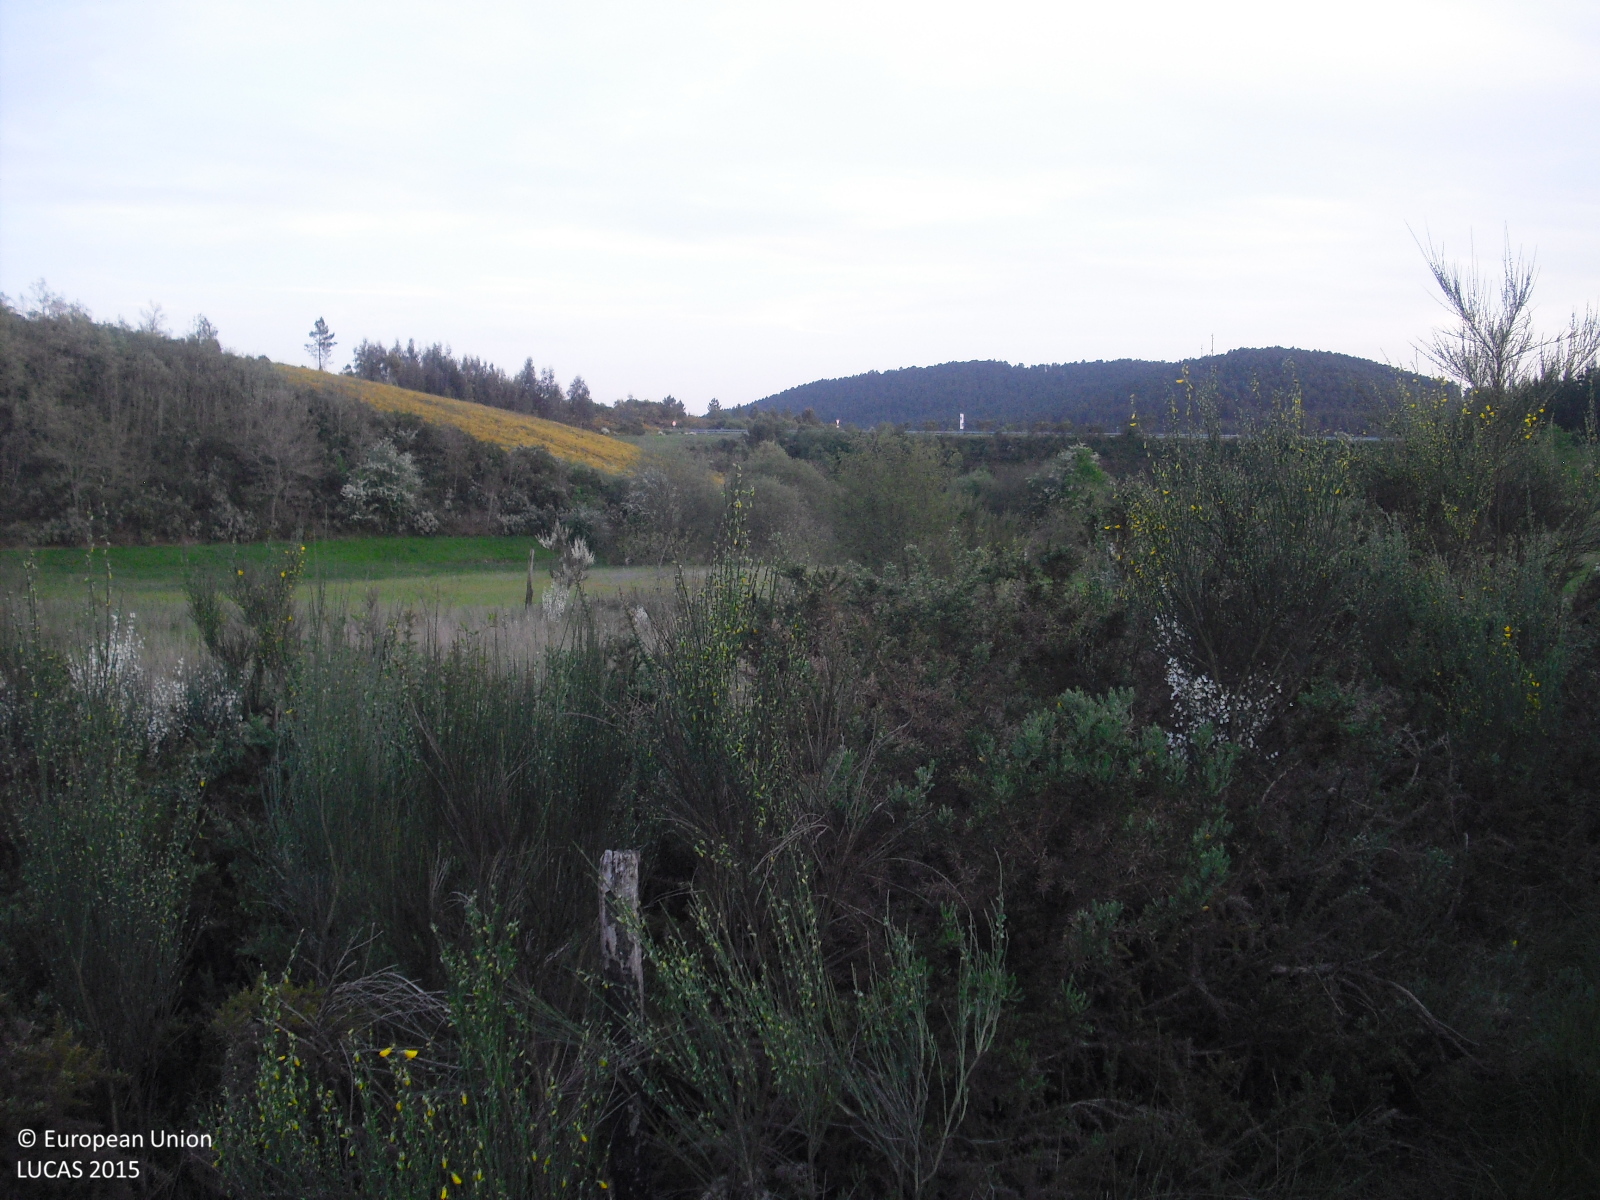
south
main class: Shrubland
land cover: Shrubland with sparse tree cover
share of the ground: > 75 %
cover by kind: shrubs 95 %, broadleaved forest trees 5 %
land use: Abandoned areas
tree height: < 5 m
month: May
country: ES
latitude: 41.9548
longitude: -7.3458
